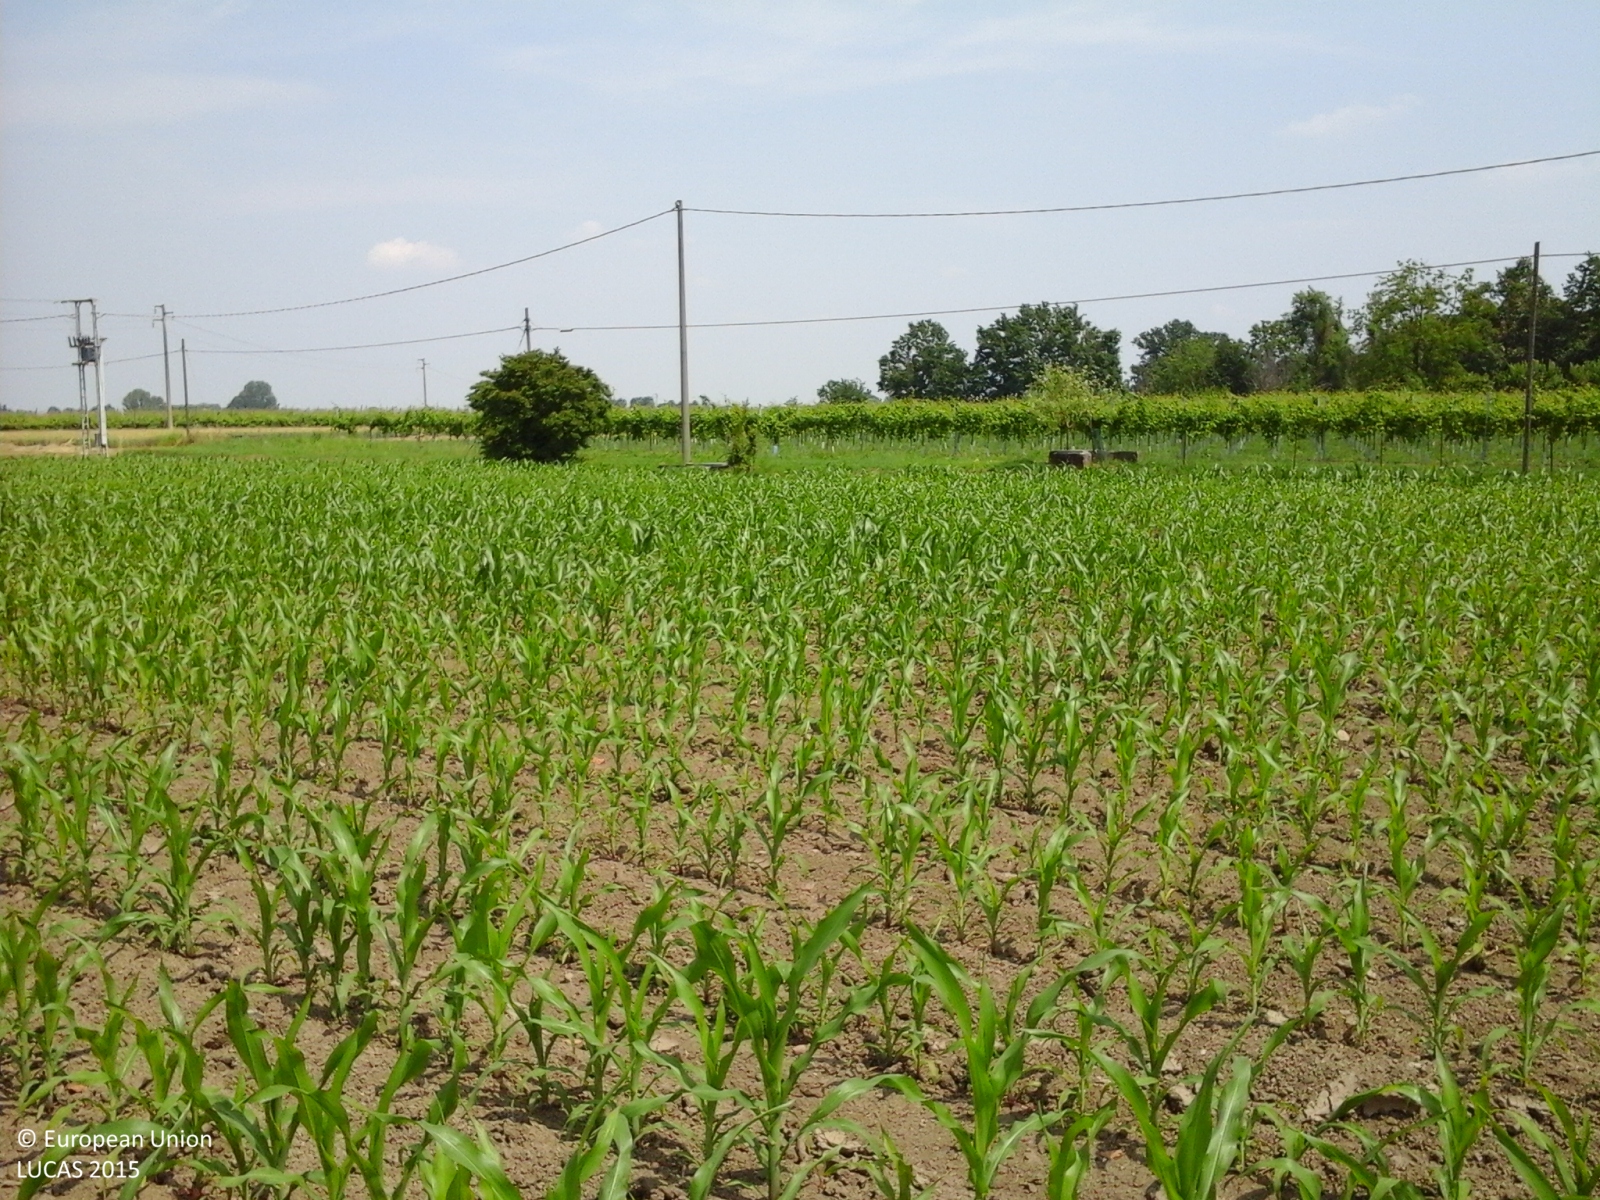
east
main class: Cropland
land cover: Maize
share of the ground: 50 - 75 %
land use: Agriculture (excluding fallow land and kitchen gardens)
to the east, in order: Maize; Ditches and canals; Electric lines; Paved roads, cycling and walking lanes; Grass margins; Ditches and canals; Grassland without tree/shrub cover; Fences; Vineyards; Common wheat; Electric lines; Vineyards
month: May
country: IT
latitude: 44.7809
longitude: 10.7189
